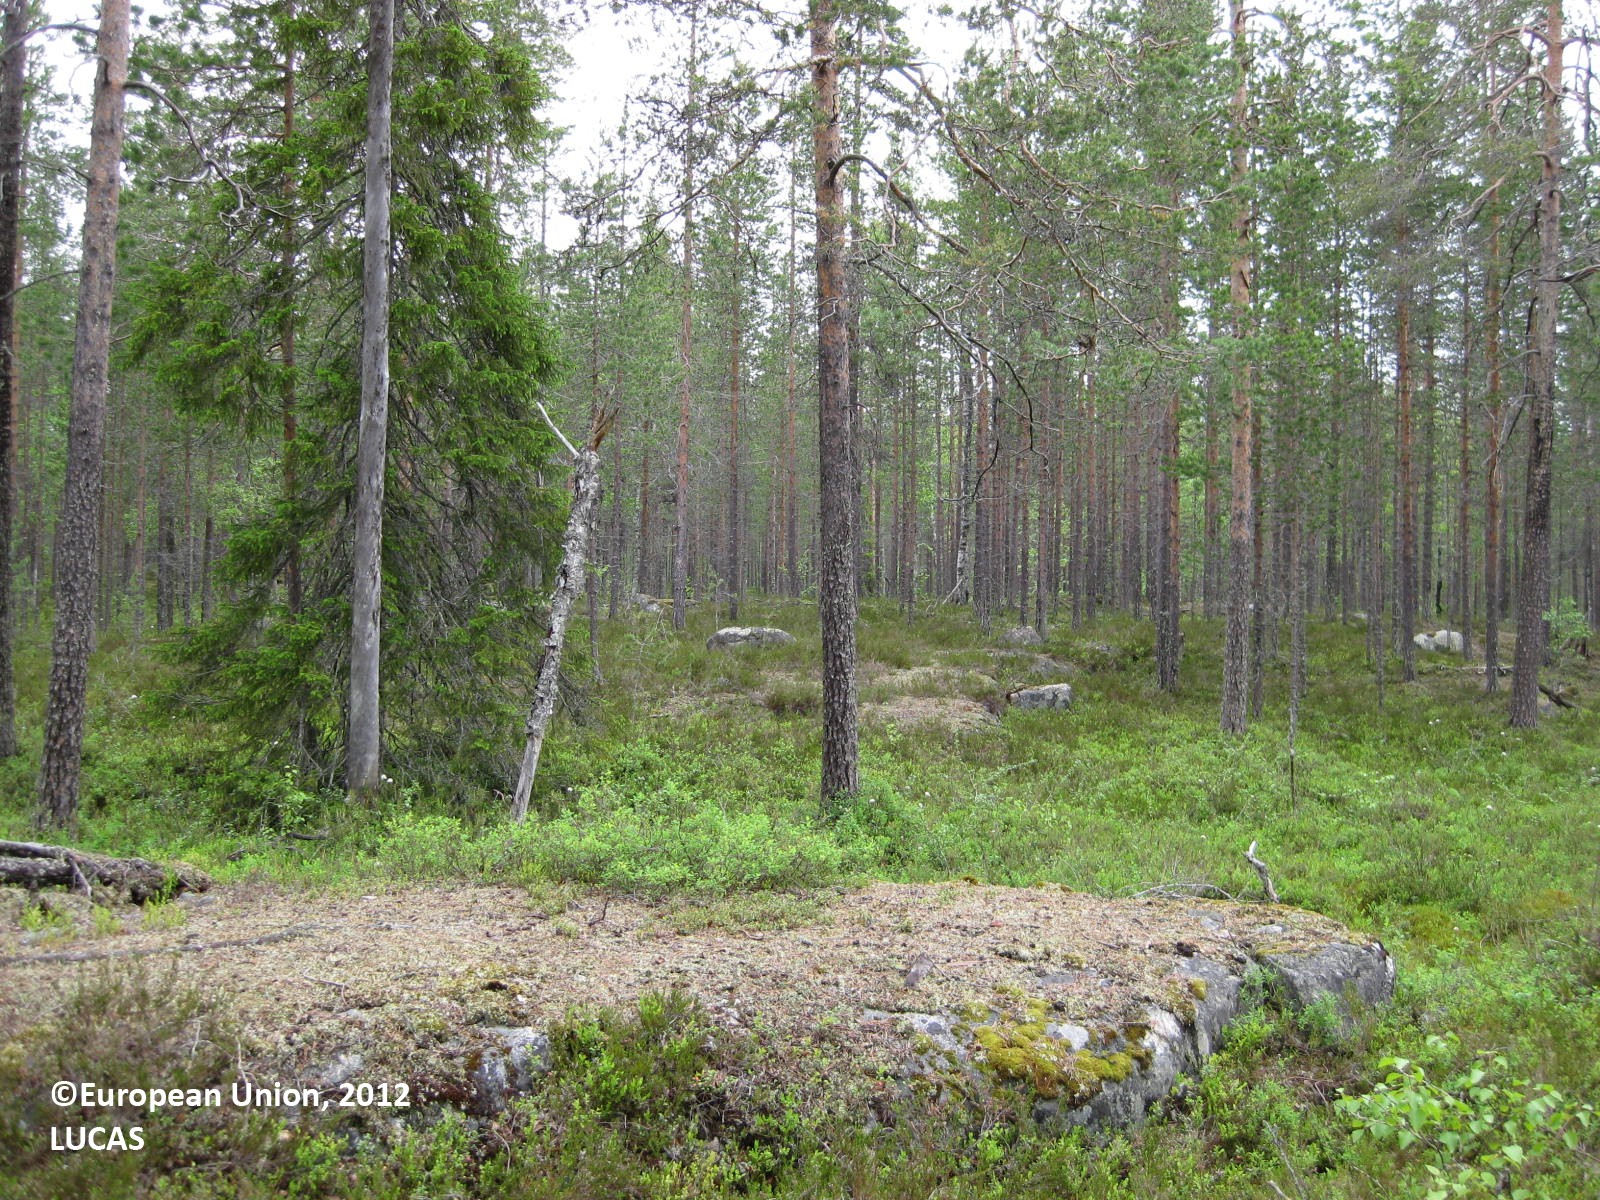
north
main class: Woodland
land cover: Pine dominated coniferous woodland
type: boreal forest
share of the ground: 50 - 75 %
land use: Forestry
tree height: > 5 m
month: June
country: FI
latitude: 65.1060
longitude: 29.2945
